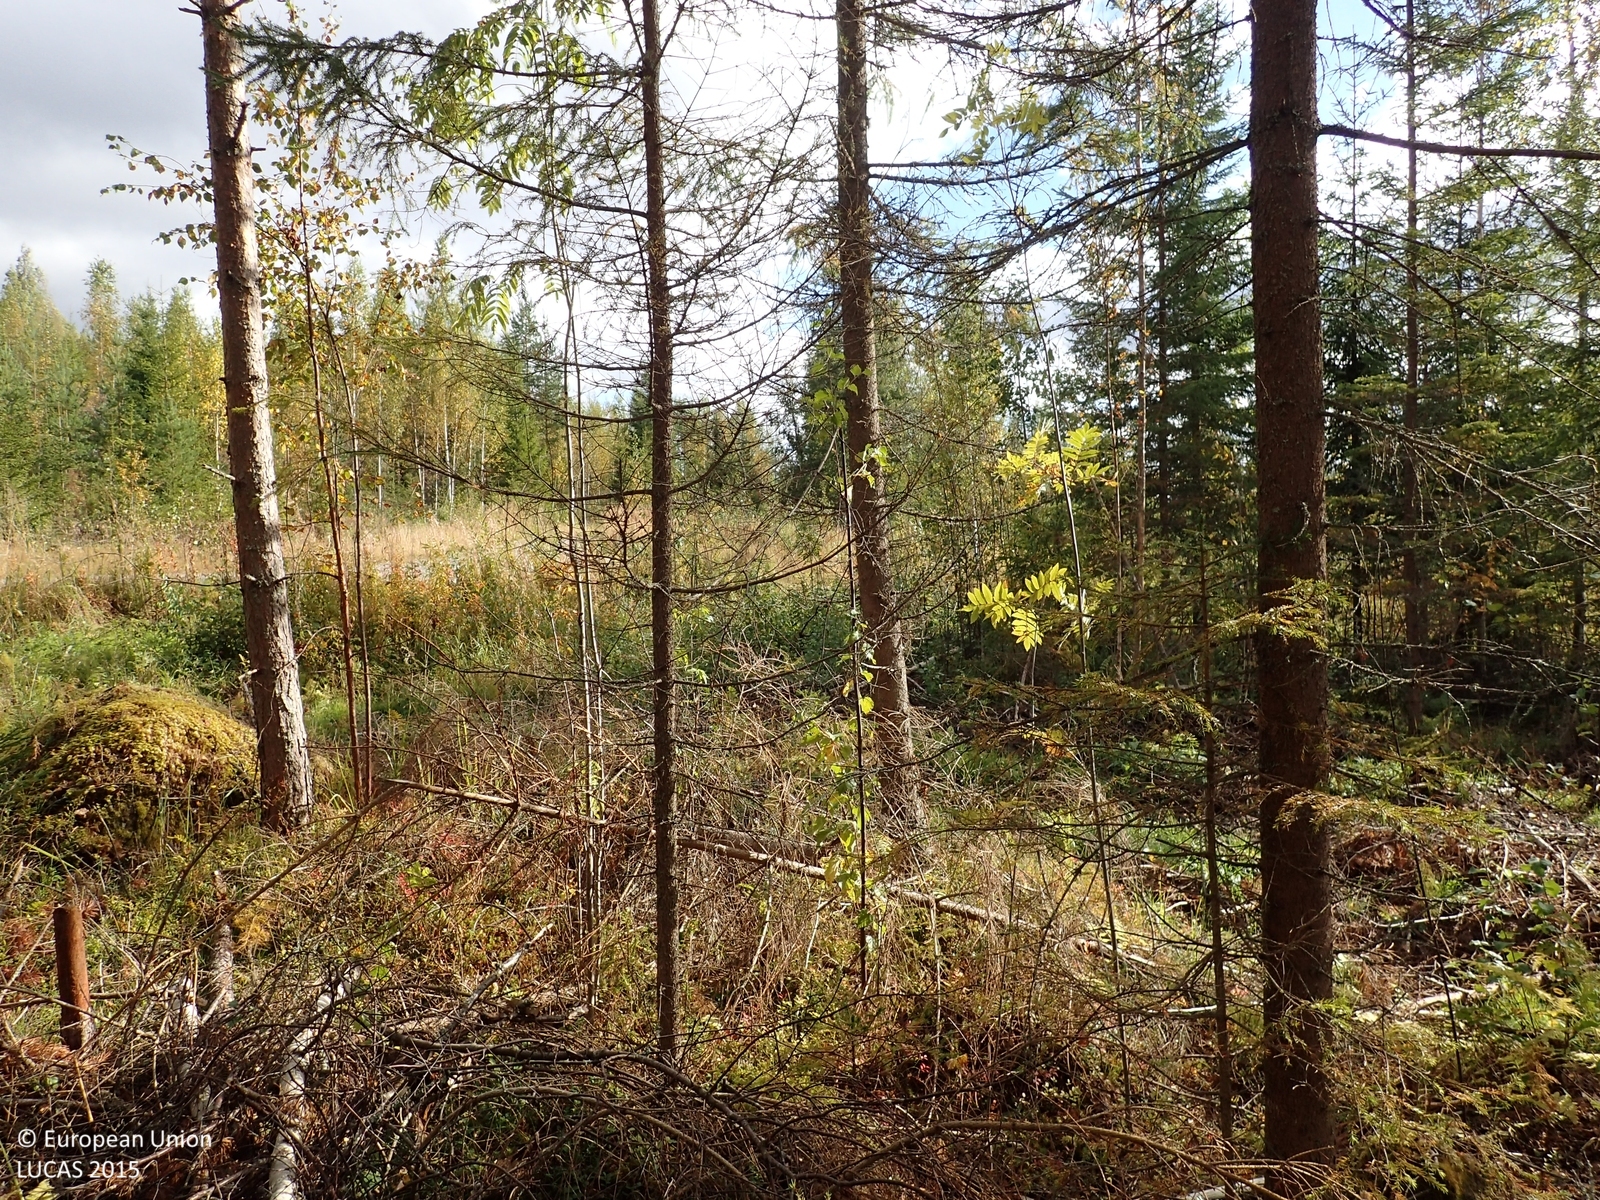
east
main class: Woodland
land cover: Spruce dominated mixed woodland
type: boreal forest
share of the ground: > 75 %
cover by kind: coniferous forest trees 55 %, broadleaved forest trees 20 %, shrubs 15 %, herbaceous plants 5 %, lichens and mosses 5 %
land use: Forestry
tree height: > 5 m
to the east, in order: Spruce dominated mixed woodland; Ditches and canals; Shruby margins; Paved roads, cycling and walking lanes; Spruce dominated mixed woodland; Pine dominated mixed woodland
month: September
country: FI
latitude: 63.1296
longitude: 25.1495
